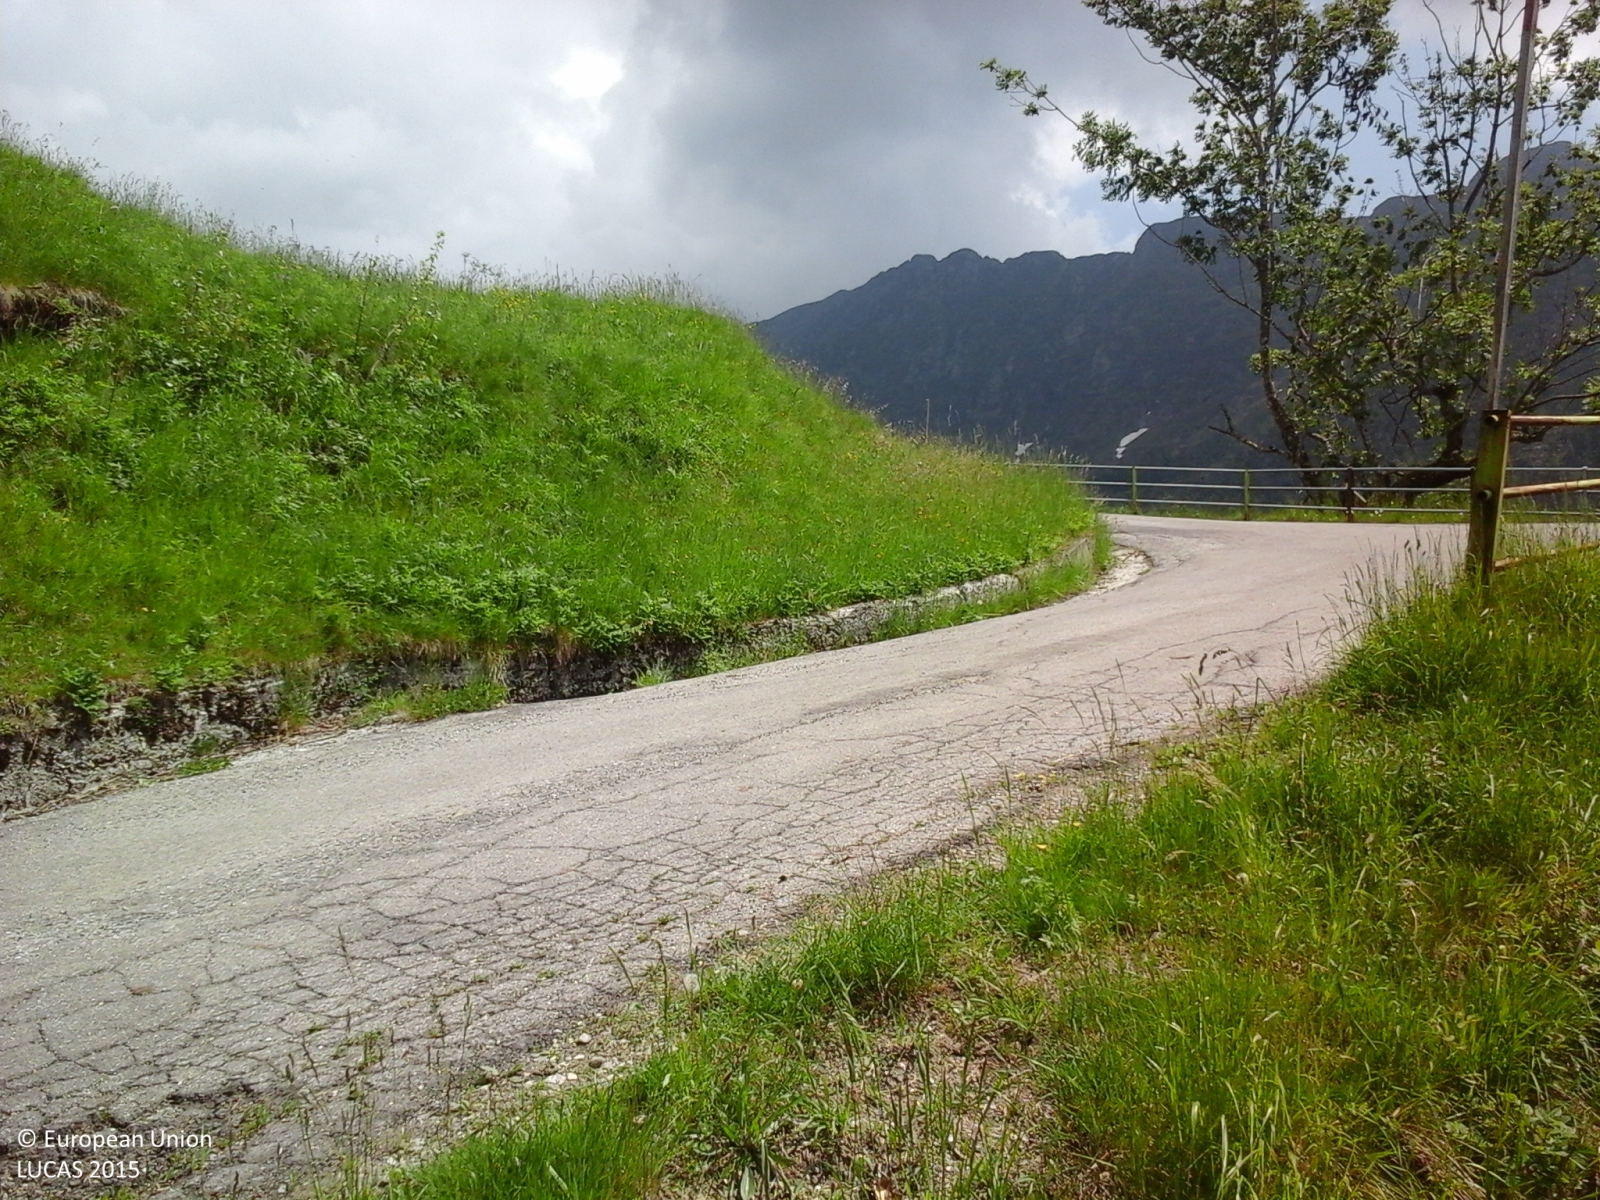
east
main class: Woodland
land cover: Other mixed woodland
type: mountainous beech forest
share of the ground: > 75 %
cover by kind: broadleaved forest trees 75 %, coniferous forest trees 25 %
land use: Forestry
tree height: > 5 m
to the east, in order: Other mixed woodland
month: June
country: IT
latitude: 45.9034
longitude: 8.1851
